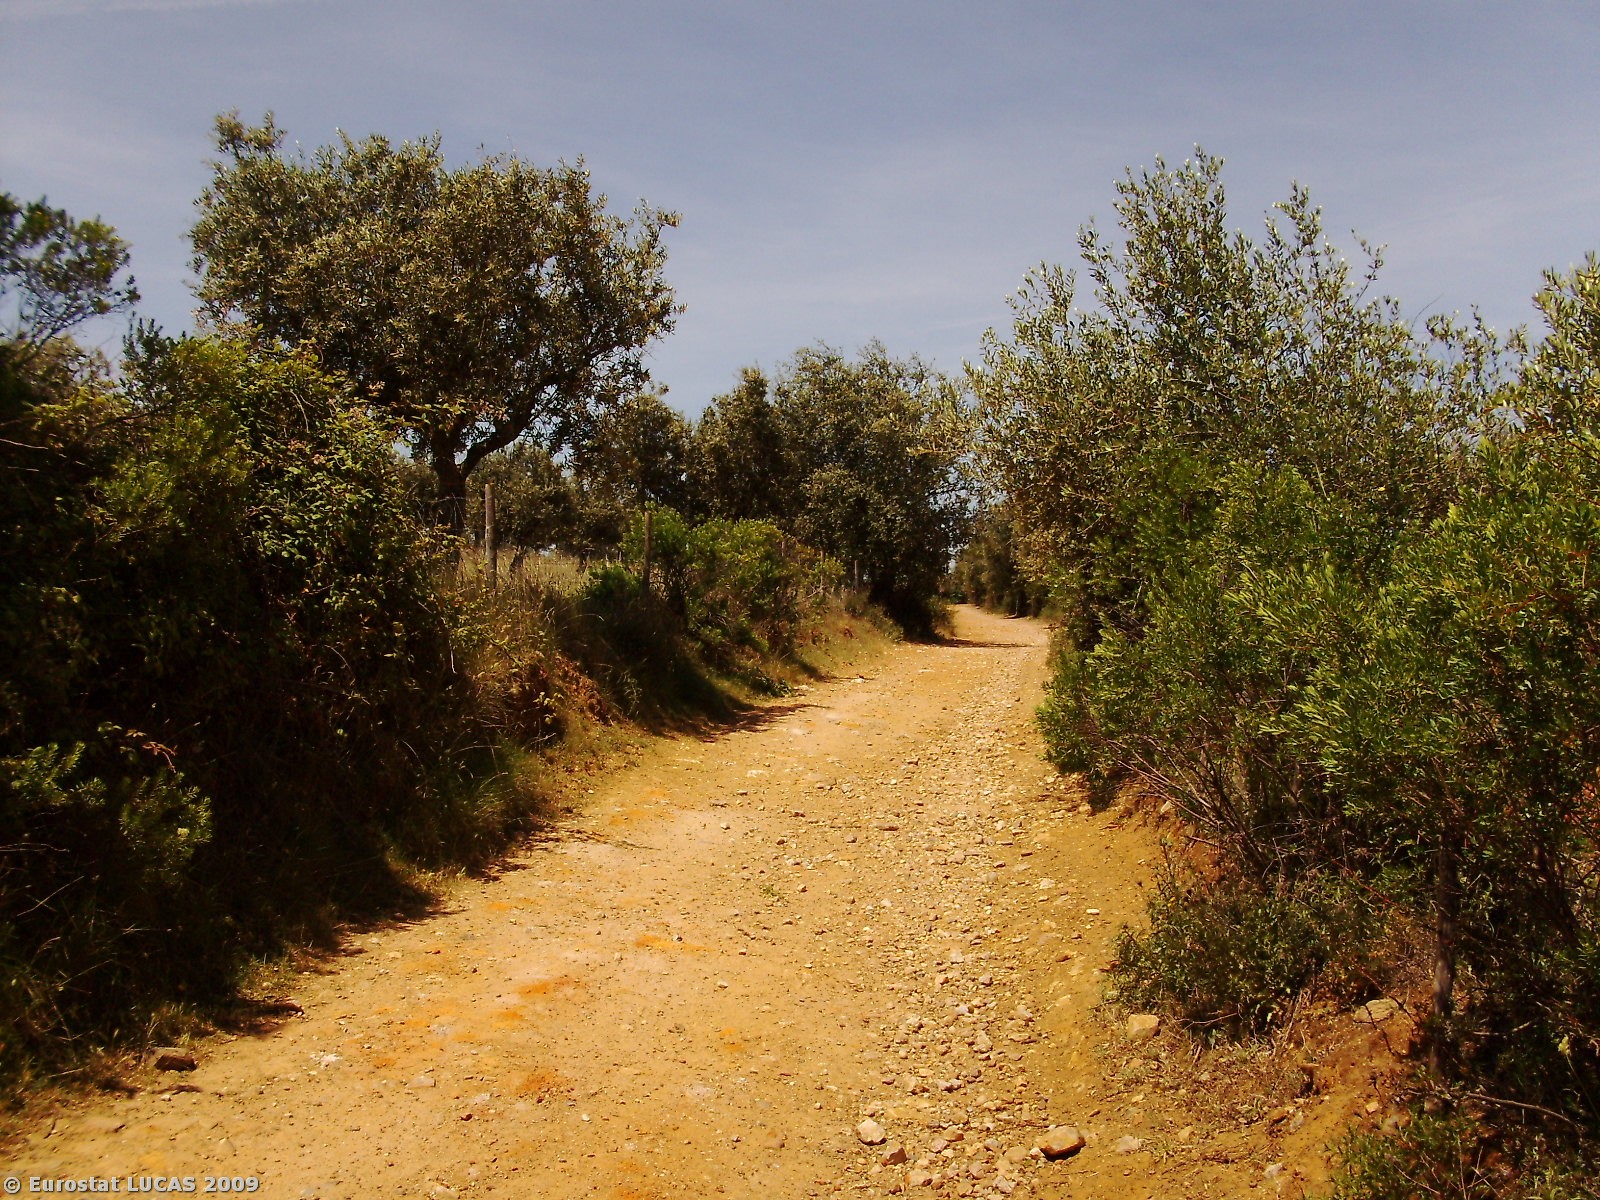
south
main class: Cropland
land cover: Olive groves
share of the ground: 50 - 75 %
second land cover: Bare land
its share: 25 - 50 %
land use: Agriculture (excluding fallow land and kitchen gardens)
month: May
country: PT
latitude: 39.1638
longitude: -7.9797
